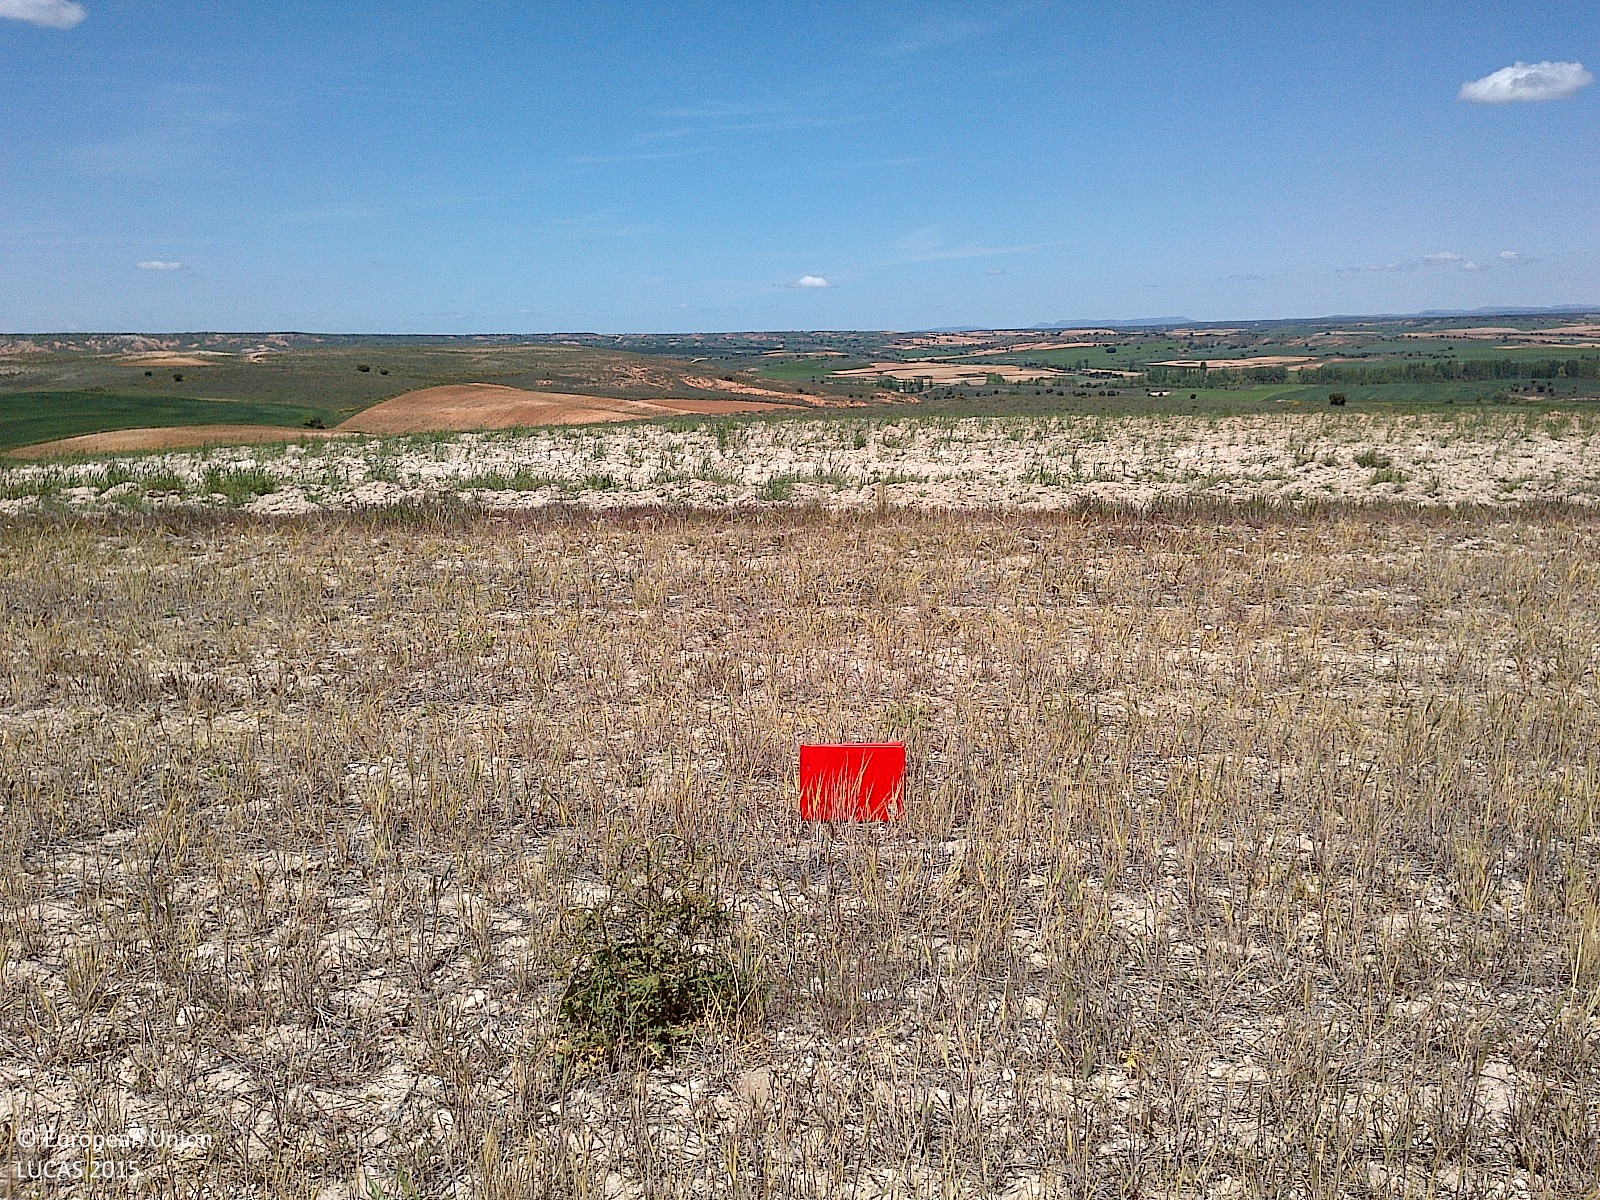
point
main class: Cropland
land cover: Barley
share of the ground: 25 - 50 %
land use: Fallow land
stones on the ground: < 10 %
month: May
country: ES
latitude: 41.6167
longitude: -3.2350
